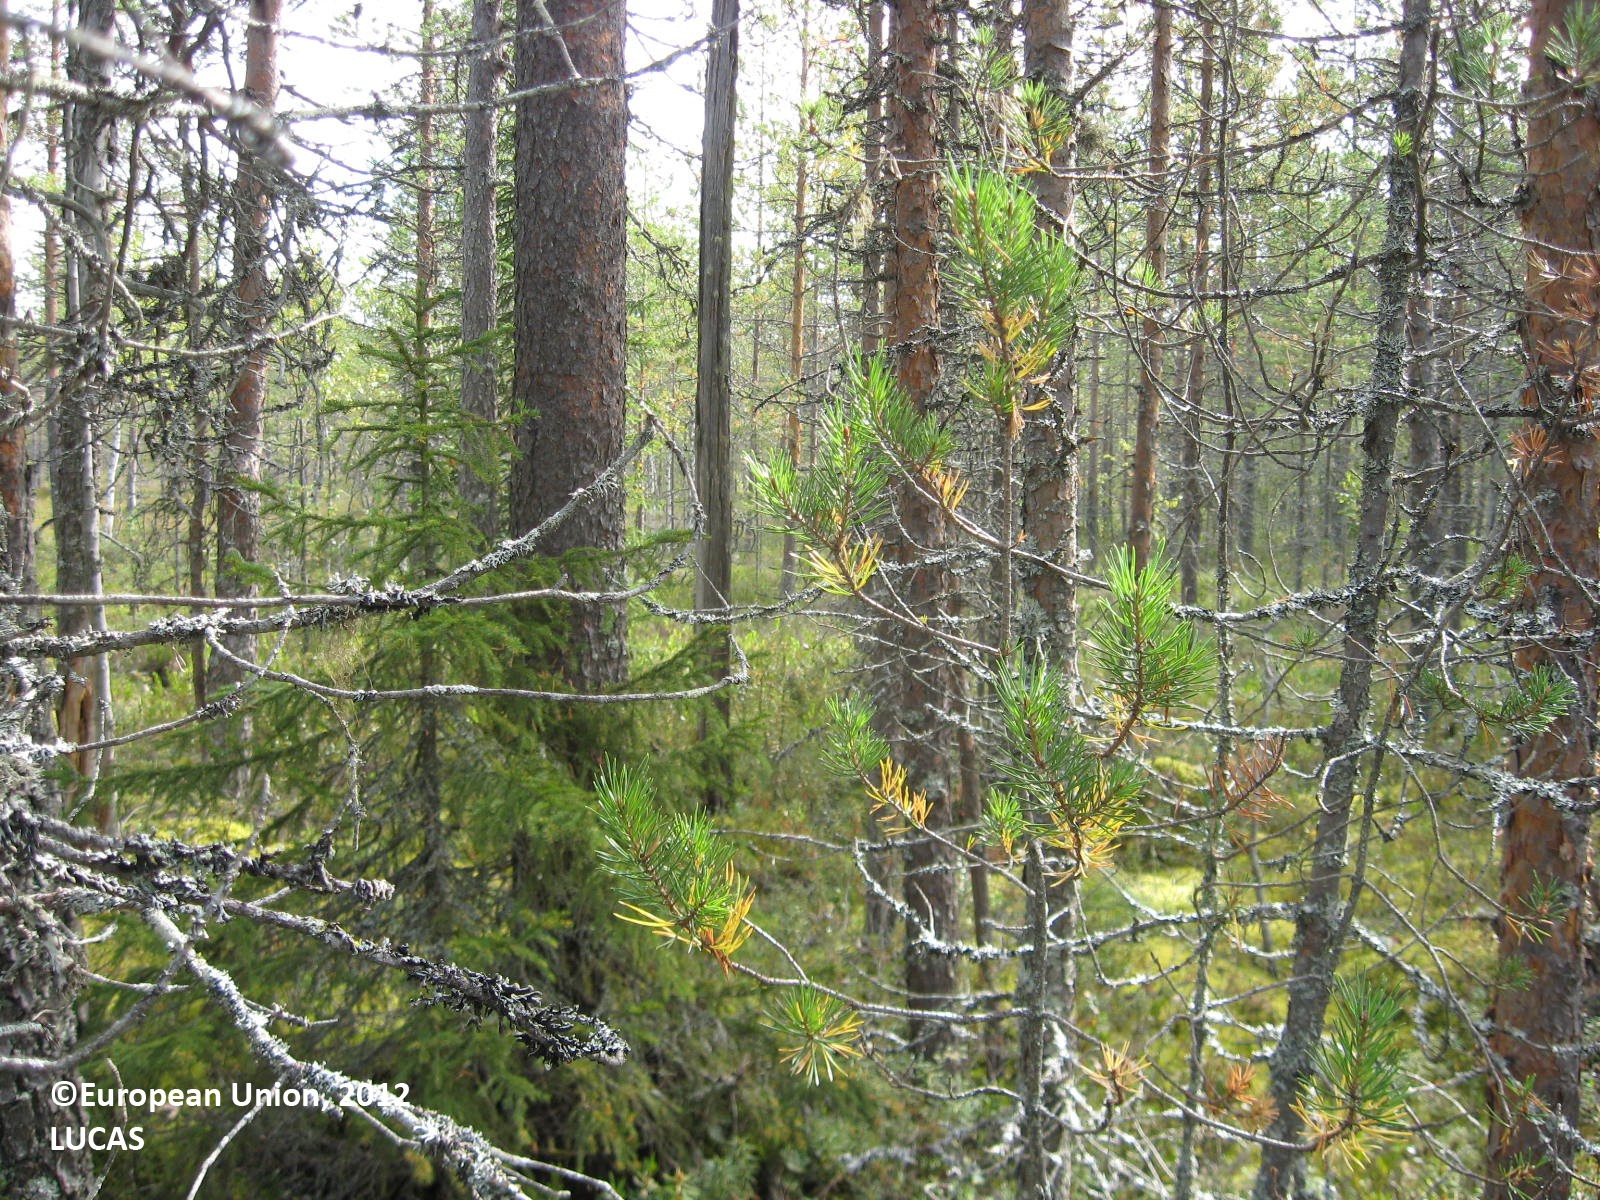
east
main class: Woodland
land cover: Pine dominated coniferous woodland
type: boreal forest
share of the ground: 50 - 75 %
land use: Forestry
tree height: > 5 m
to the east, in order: Pine dominated coniferous woodland; Ditches and canals; Pine dominated coniferous woodland; Ditches and canals; Pine dominated coniferous woodland; Ditches and canals; Pine dominated coniferous woodland; Ditches and canals; Pine dominated mixed woodland; Other mixed woodland; Ditches and canals; Shruby margins; Paved roads, cycling and walking lanes; Shruby margins; Ditches and canals; Other mixed woodland
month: August
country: FI
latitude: 63.6654
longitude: 29.5634
